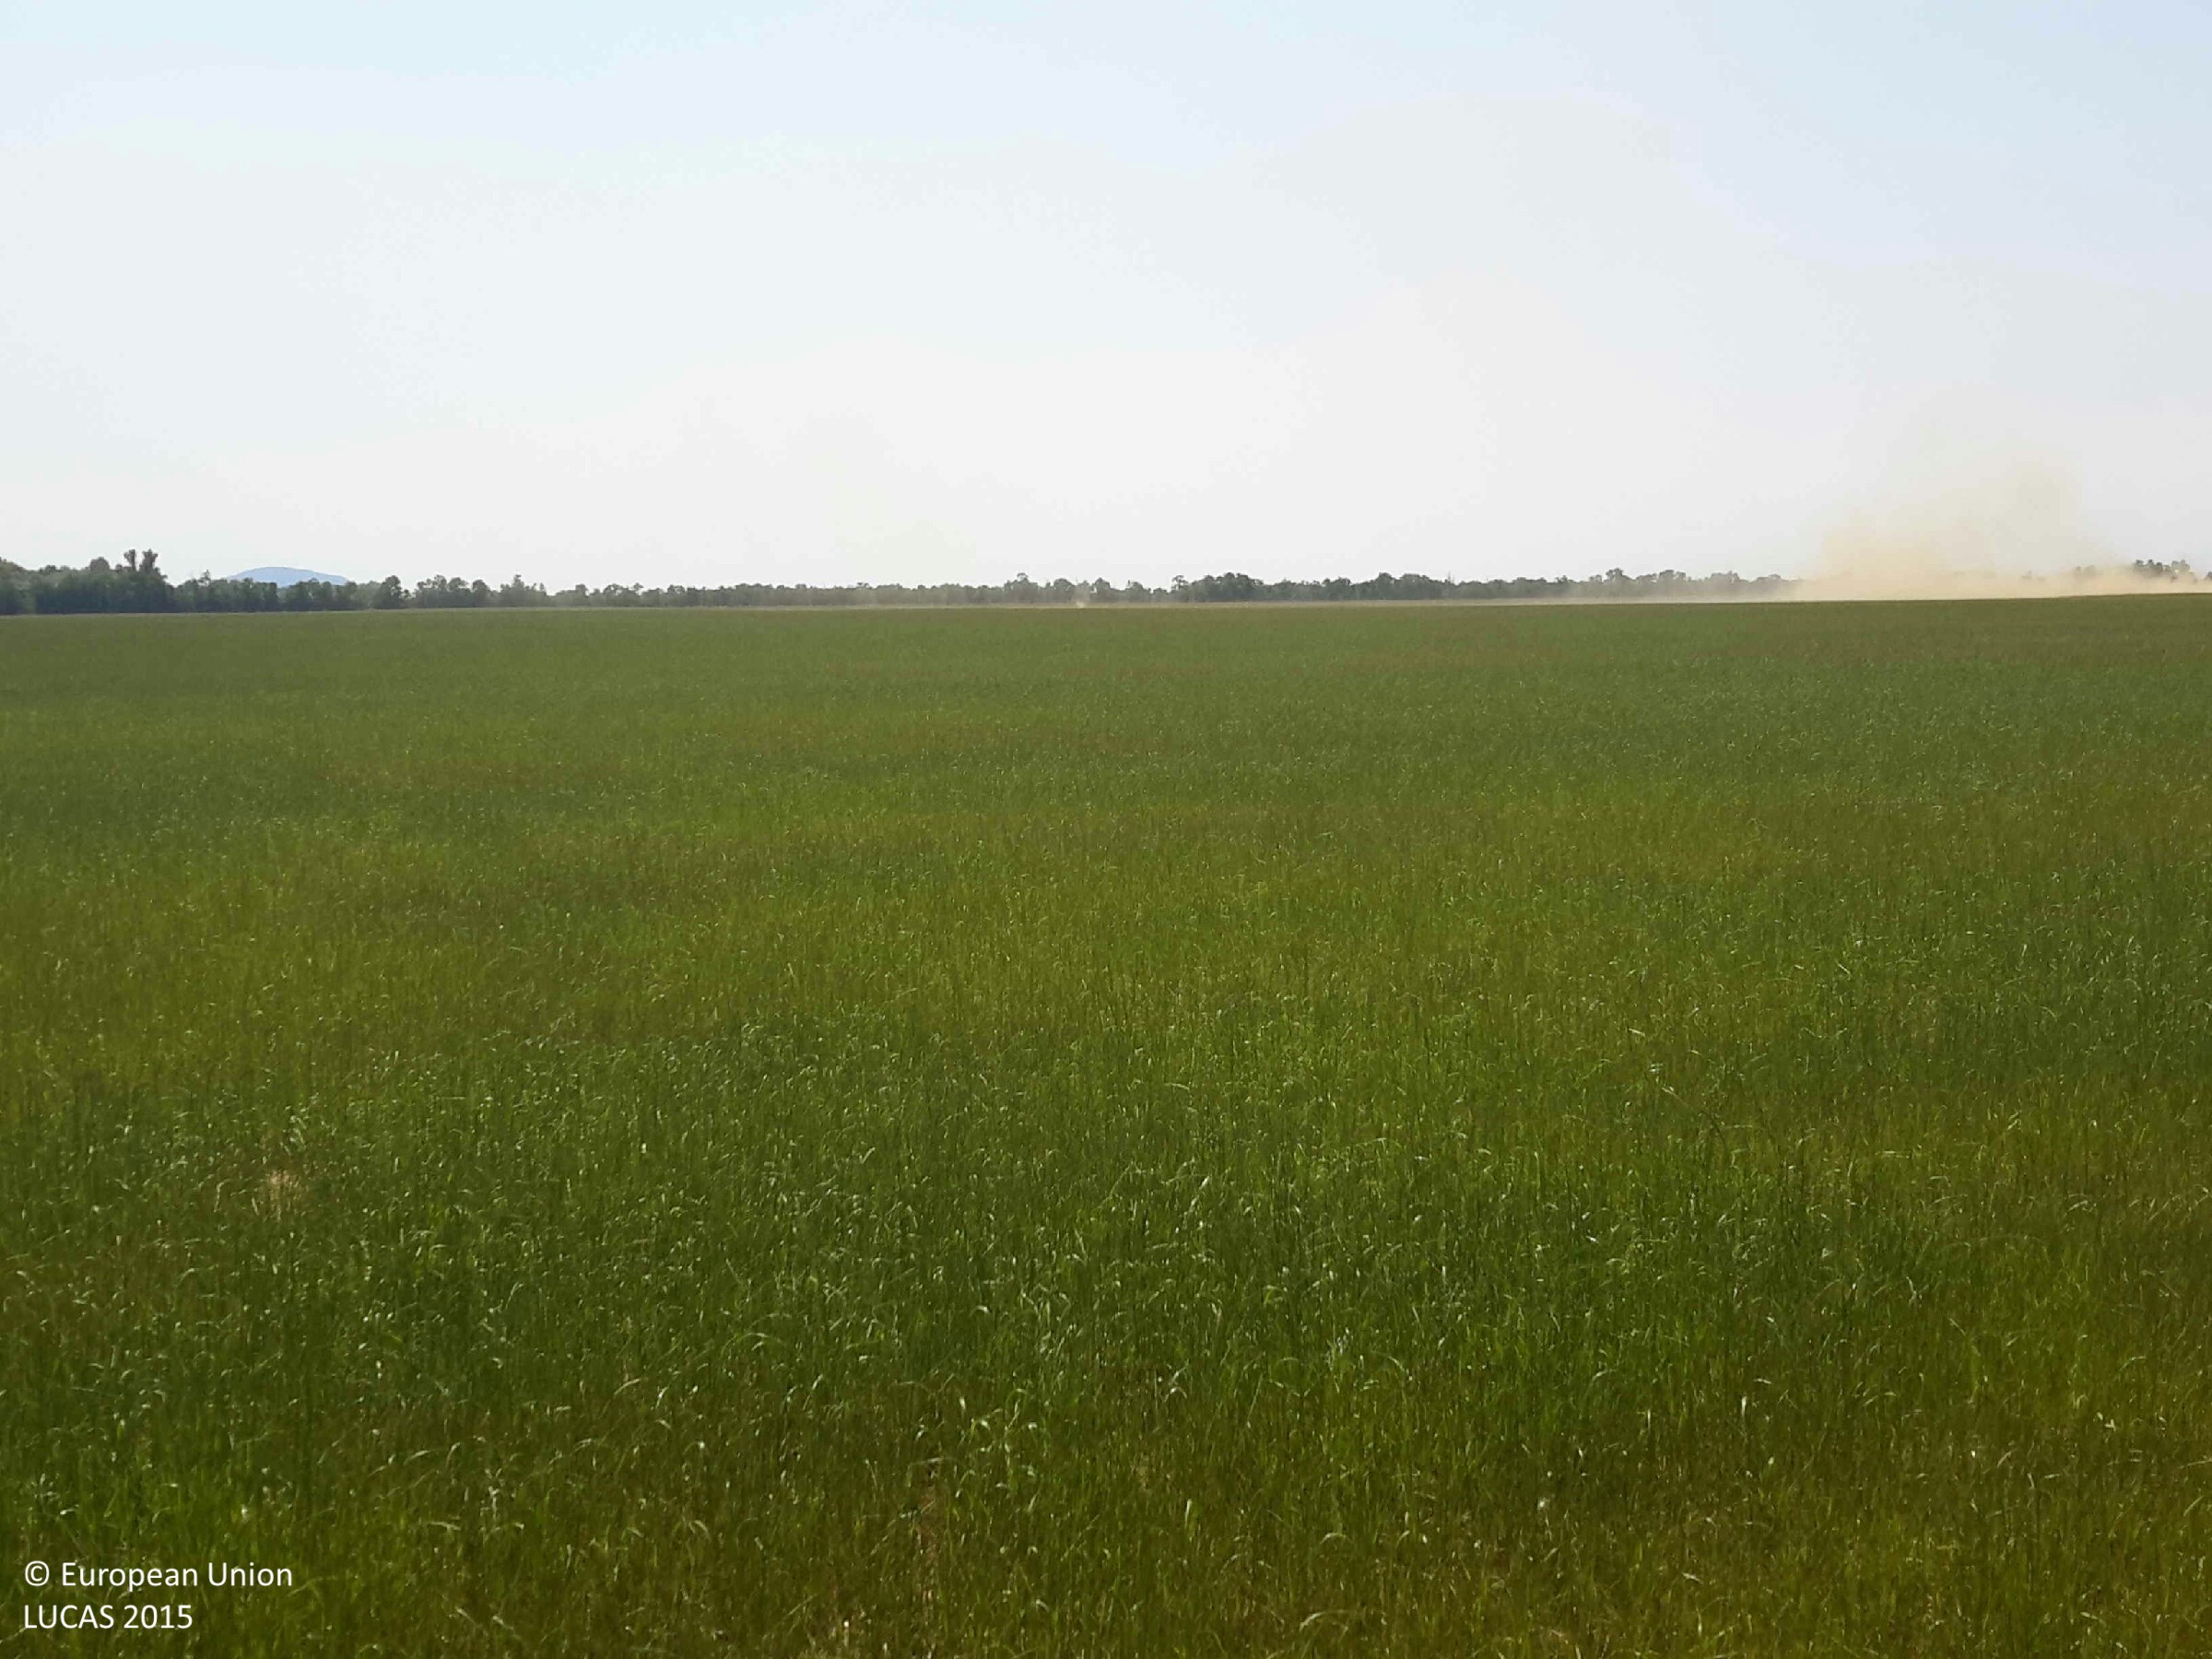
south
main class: Grassland
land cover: Grassland without tree/shrub cover
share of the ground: > 75 %
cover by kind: herbaceous plants 100 %
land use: Agriculture (excluding fallow land and kitchen gardens)
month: July
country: HU
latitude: 47.3113
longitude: 17.3217
